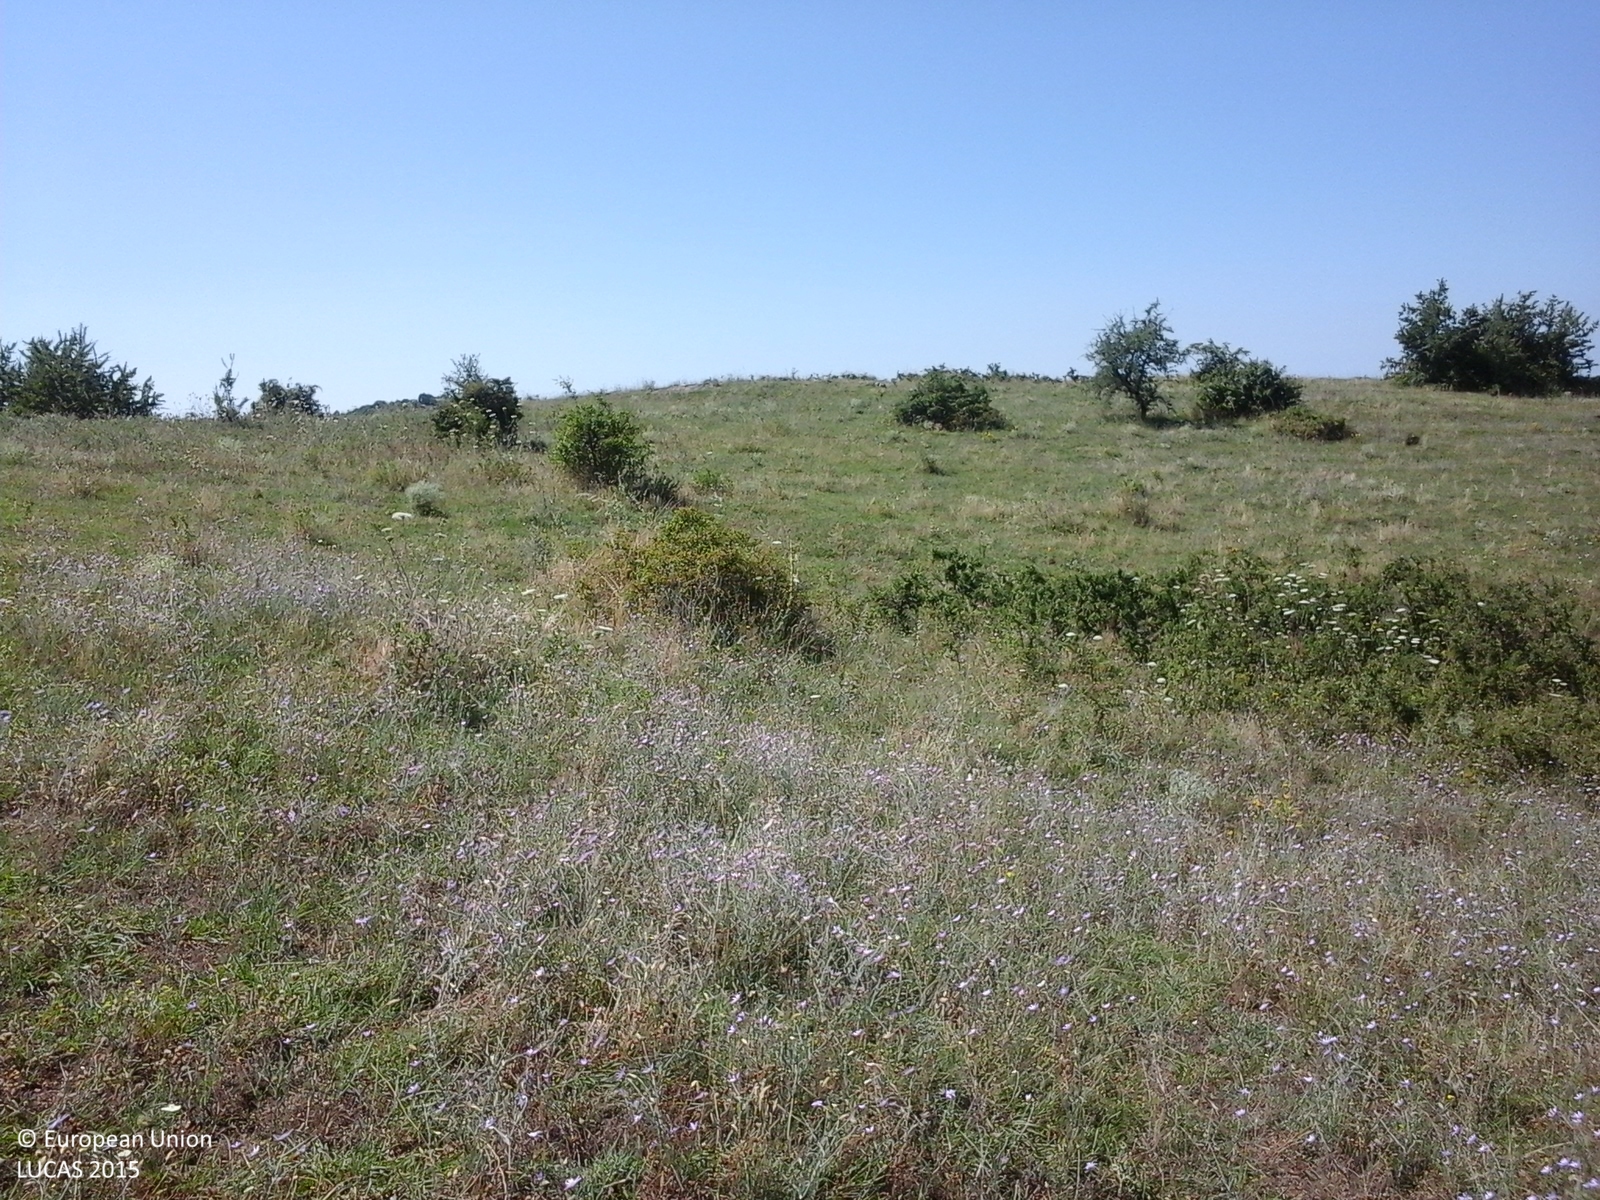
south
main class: Grassland
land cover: Grassland with sparse tree/shrub cover
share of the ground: > 75 %
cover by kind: herbaceous plants 90 %, broadleaved forest trees 5 %, shrubs 5 %
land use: Semi-natural and natural areas not in use
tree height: < 5 m
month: July
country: GR
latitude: 40.9120
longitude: 23.0358
